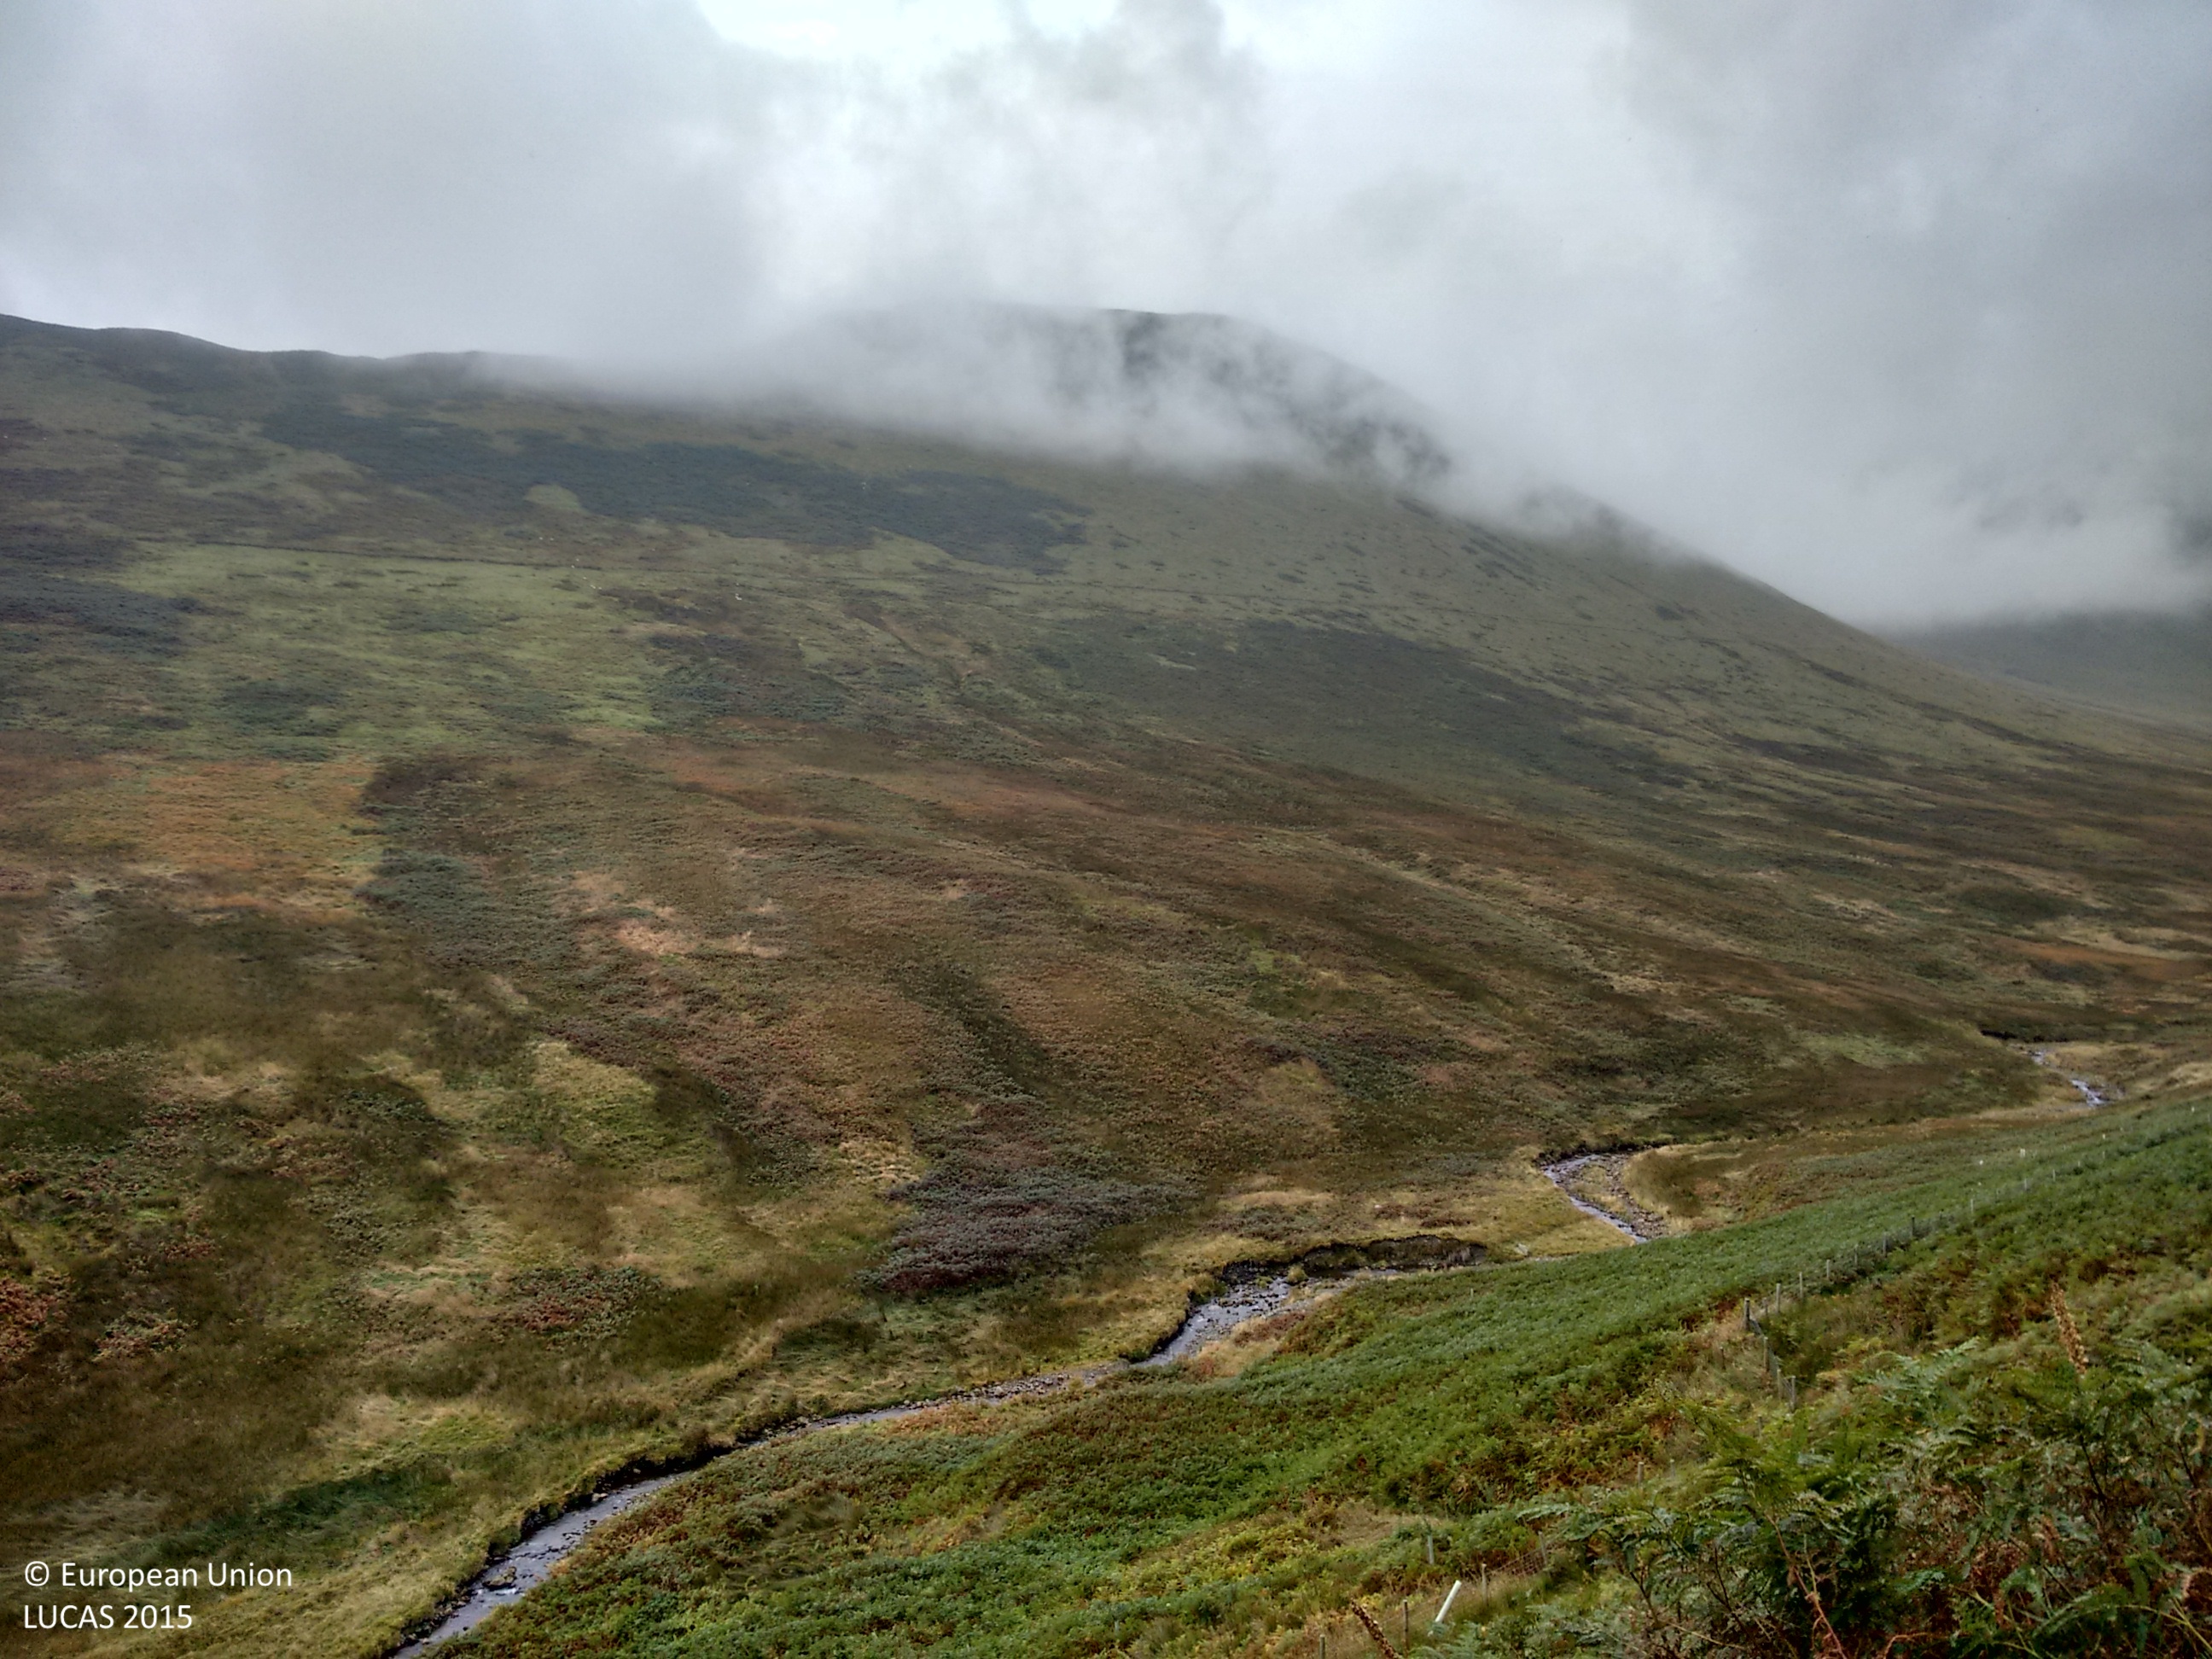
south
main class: Shrubland
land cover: Shrubland without tree cover
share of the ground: > 75 %
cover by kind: shrubs 100 %
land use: Agriculture (excluding fallow land and kitchen gardens)
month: October
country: GB
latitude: 54.5882
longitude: -3.2143
